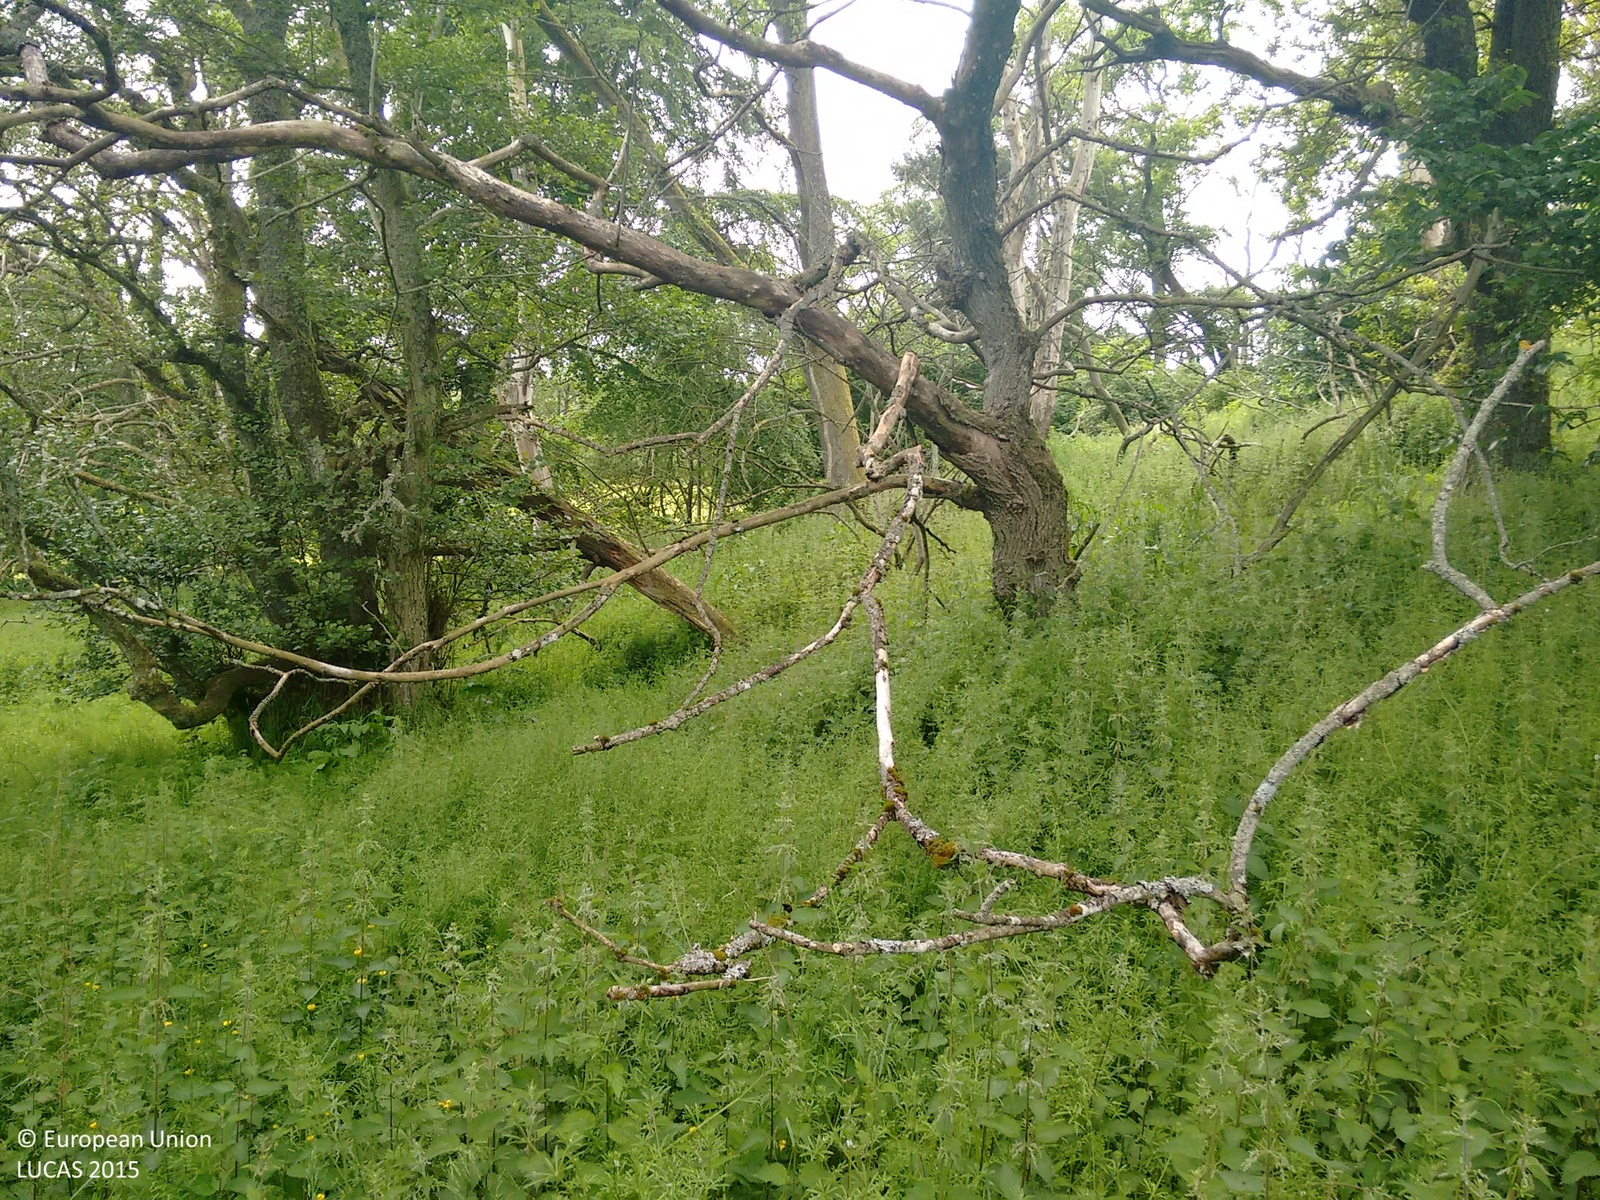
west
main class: Woodland
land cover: Broadleaved woodland
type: exotic forest
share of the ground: > 75 %
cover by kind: broadleaved forest trees 75 %, herbaceous plants 25 %
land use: Semi-natural and natural areas not in use
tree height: > 5 m
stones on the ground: < 10 %
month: June
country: GB
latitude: 57.1750
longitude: -2.7112
